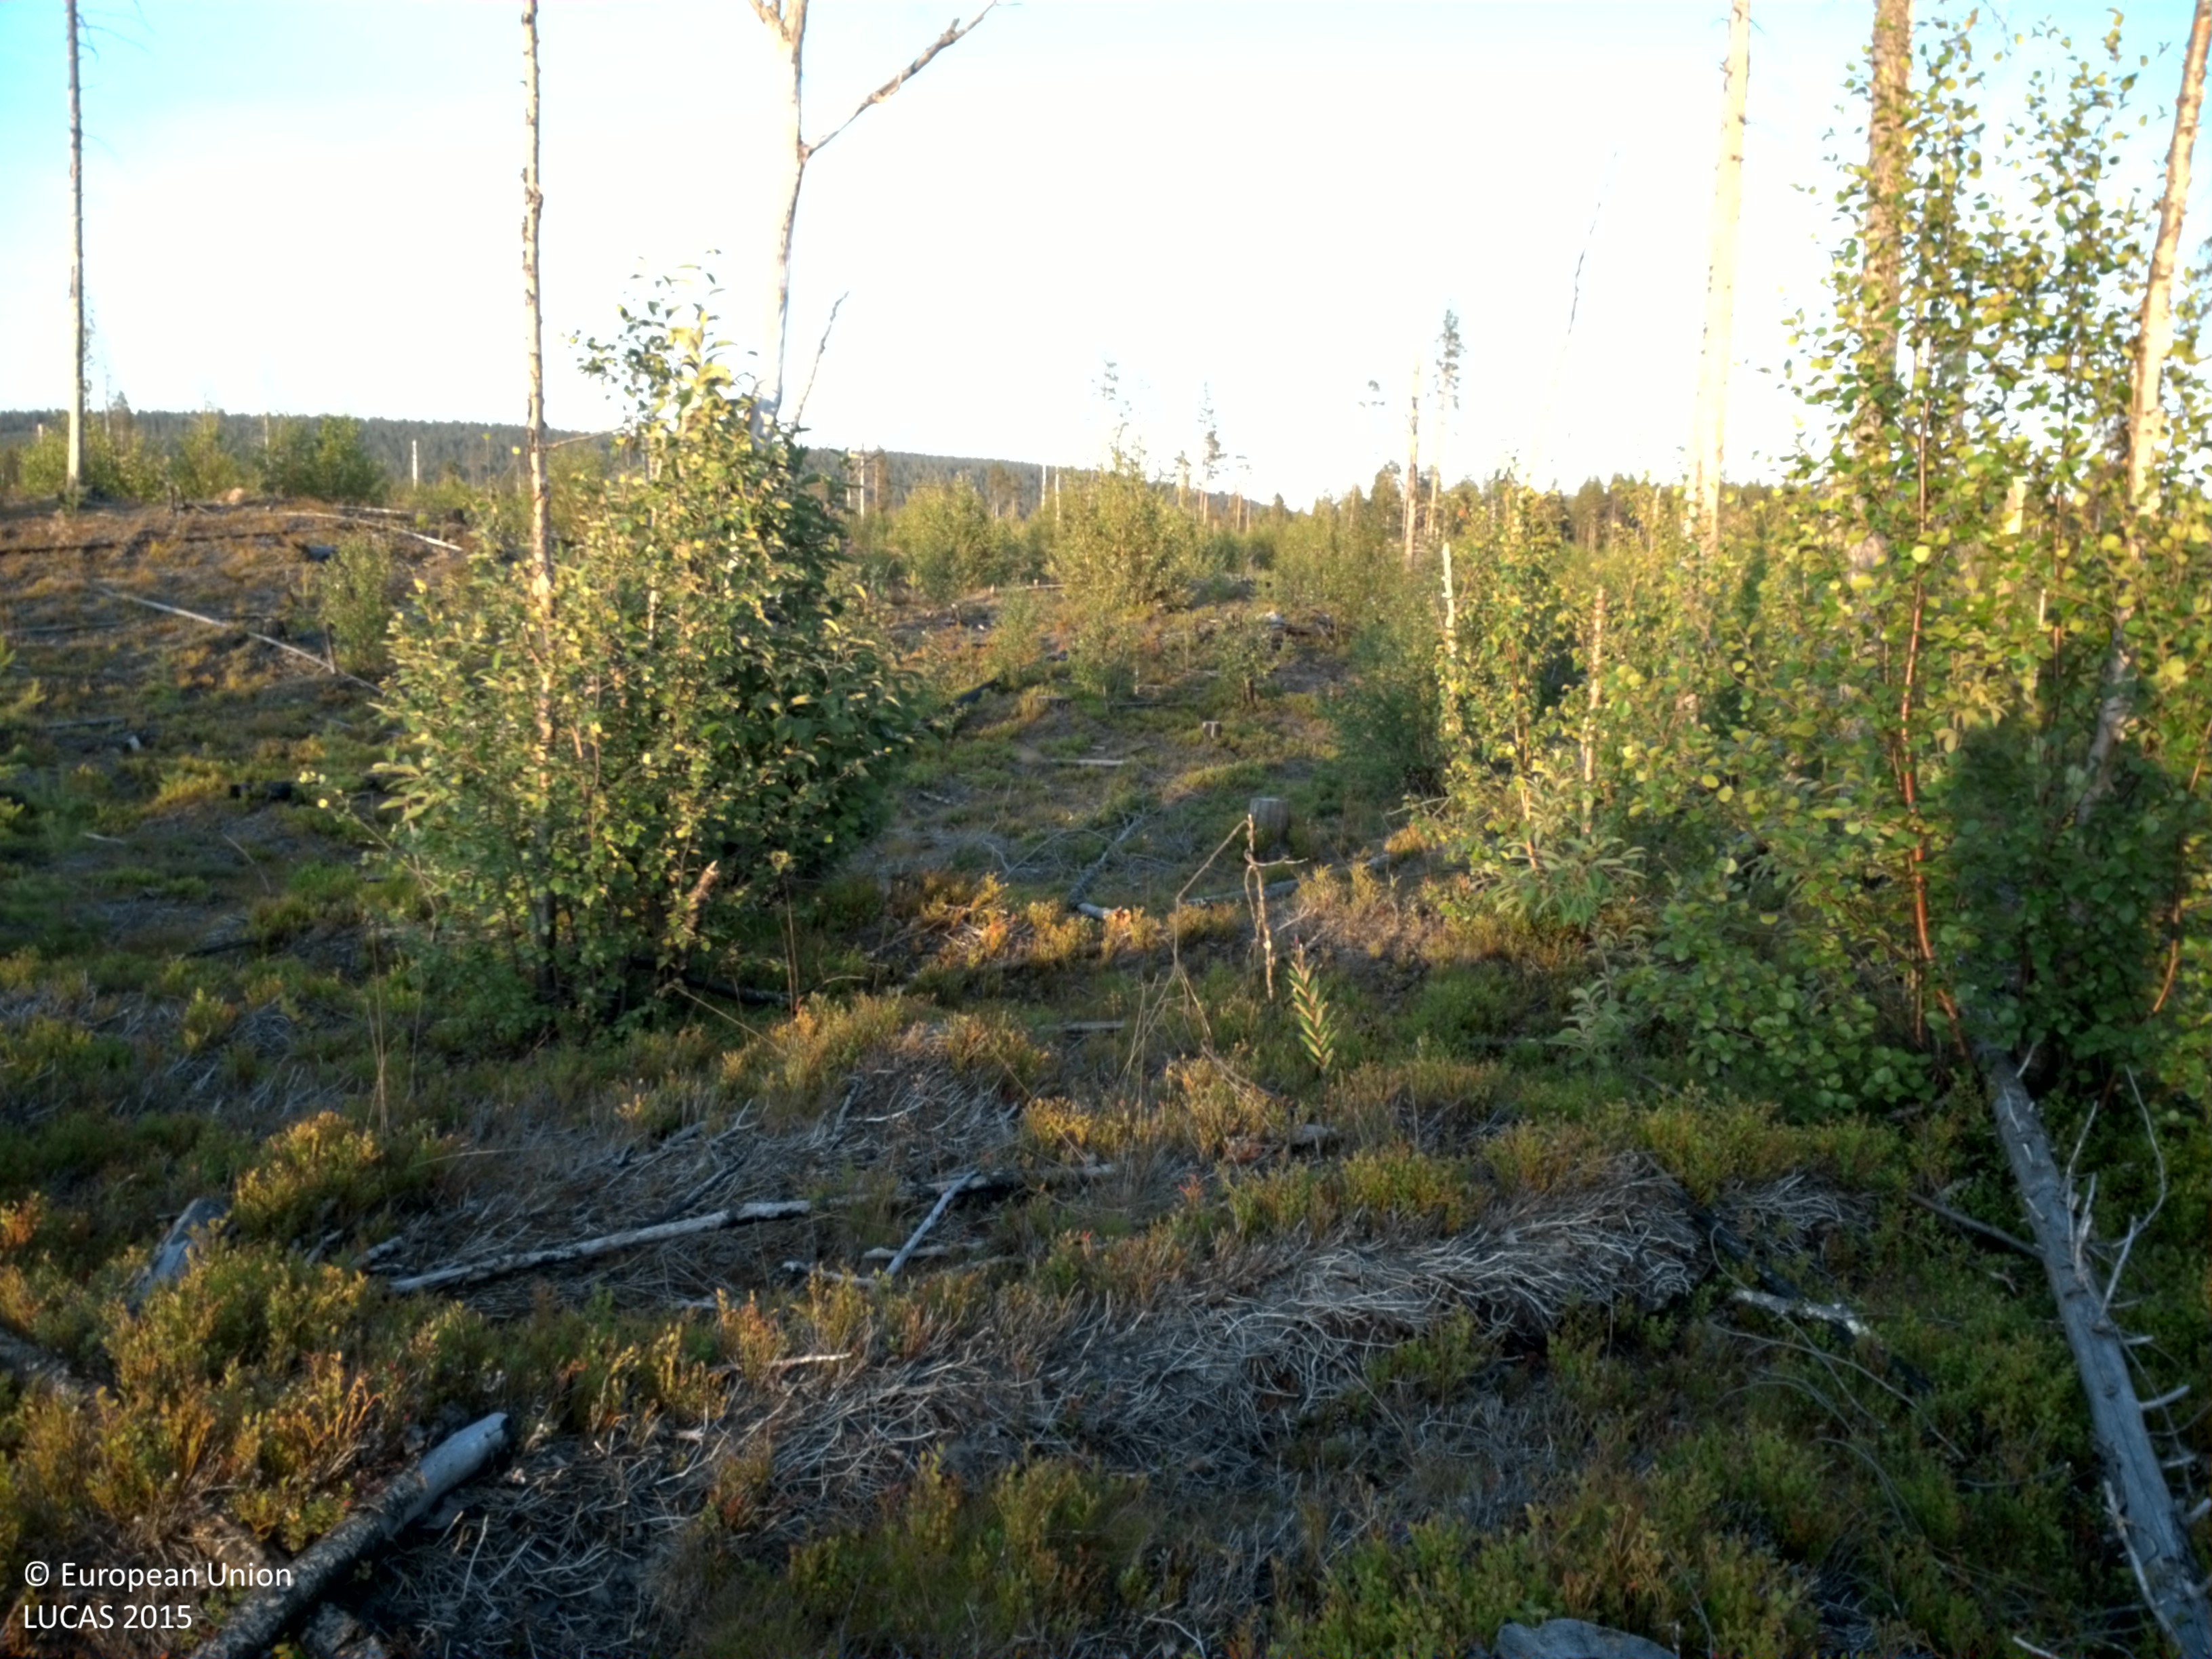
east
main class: Woodland
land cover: Broadleaved woodland
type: boreal forest
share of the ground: 10 - 25 %
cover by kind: shrubs 65 %, broadleaved forest trees 15 %, lichens and mosses 15 %
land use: Forestry
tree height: < 5 m
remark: Clear cut
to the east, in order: Broadleaved woodland; Shrubland with sparse tree cover; Broadleaved woodland; Paved roads, cycling and walking lanes; Groves; Shrubland with sparse tree cover
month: August
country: SE
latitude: 66.6326
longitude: 19.1010
